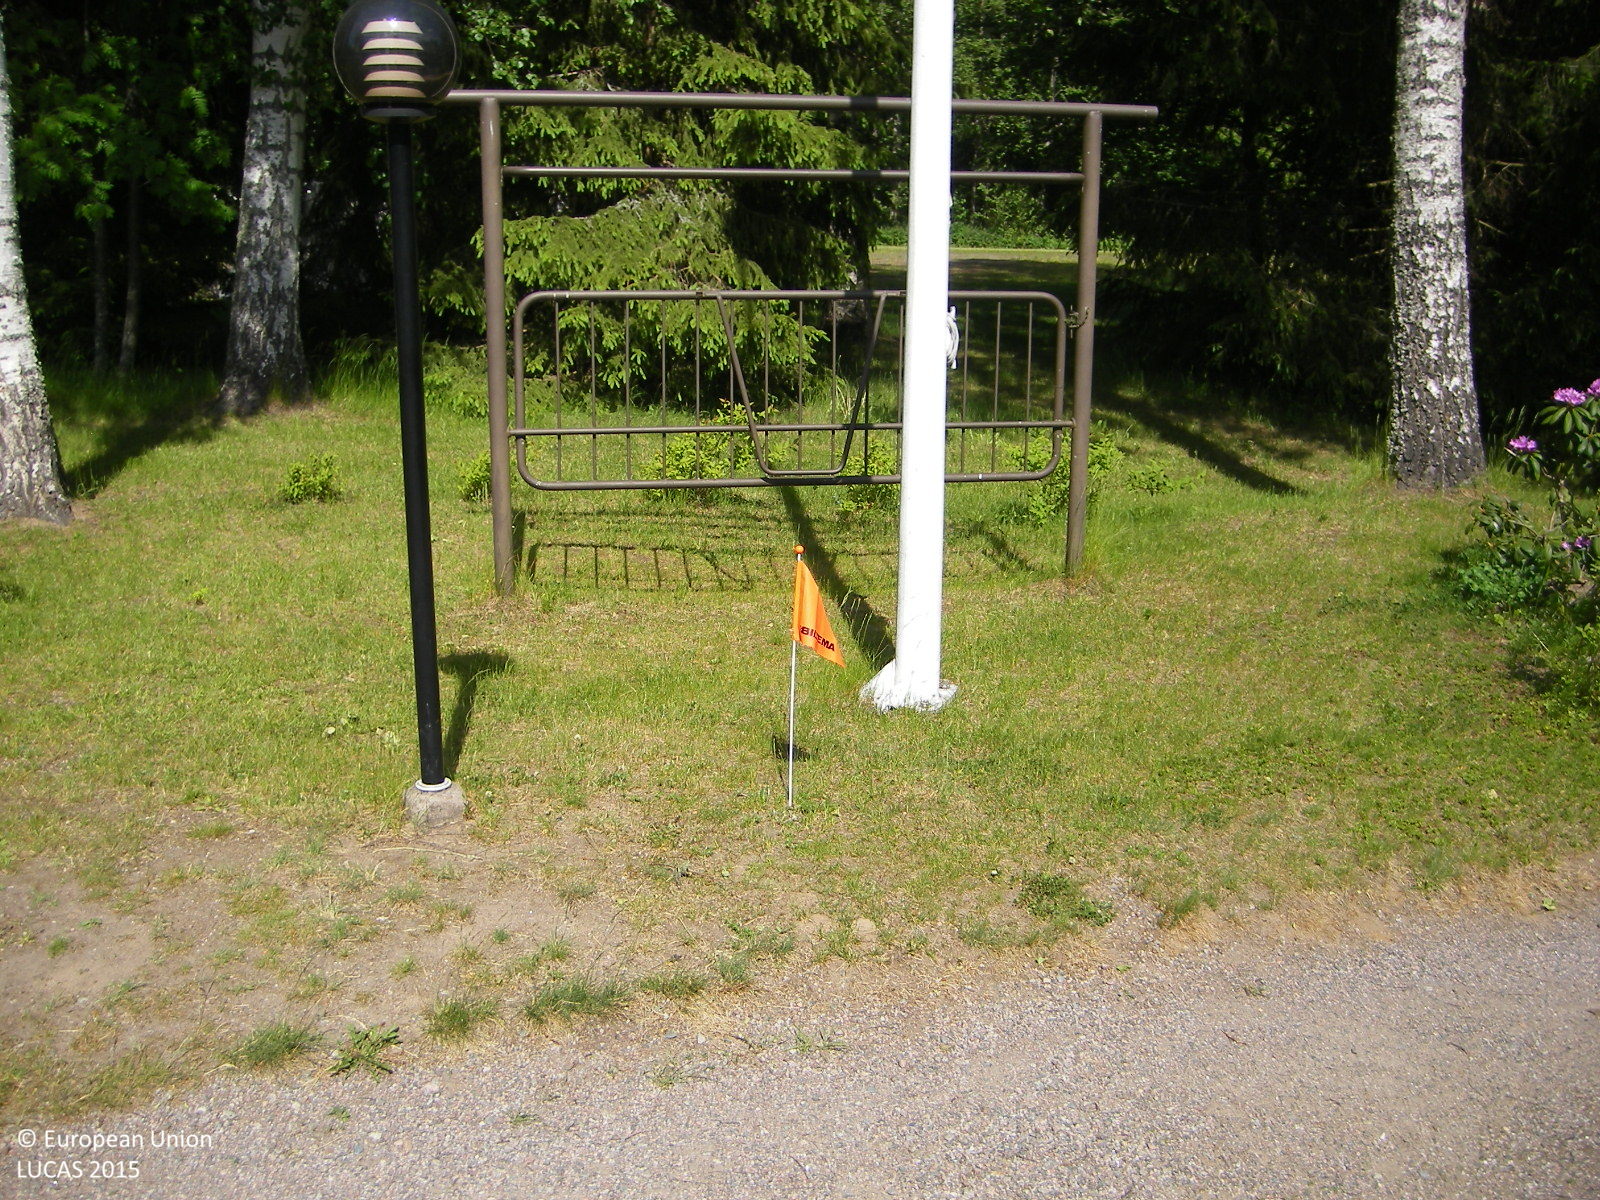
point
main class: Grassland
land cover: Grassland with sparse tree/shrub cover
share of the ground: > 75 %
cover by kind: herbaceous plants 85 %, broadleaved forest trees 5 %, shrubs 5 %, unconsolidated bare surface 5 %
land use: Residential
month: June
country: FI
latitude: 60.3707
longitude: 24.4126
